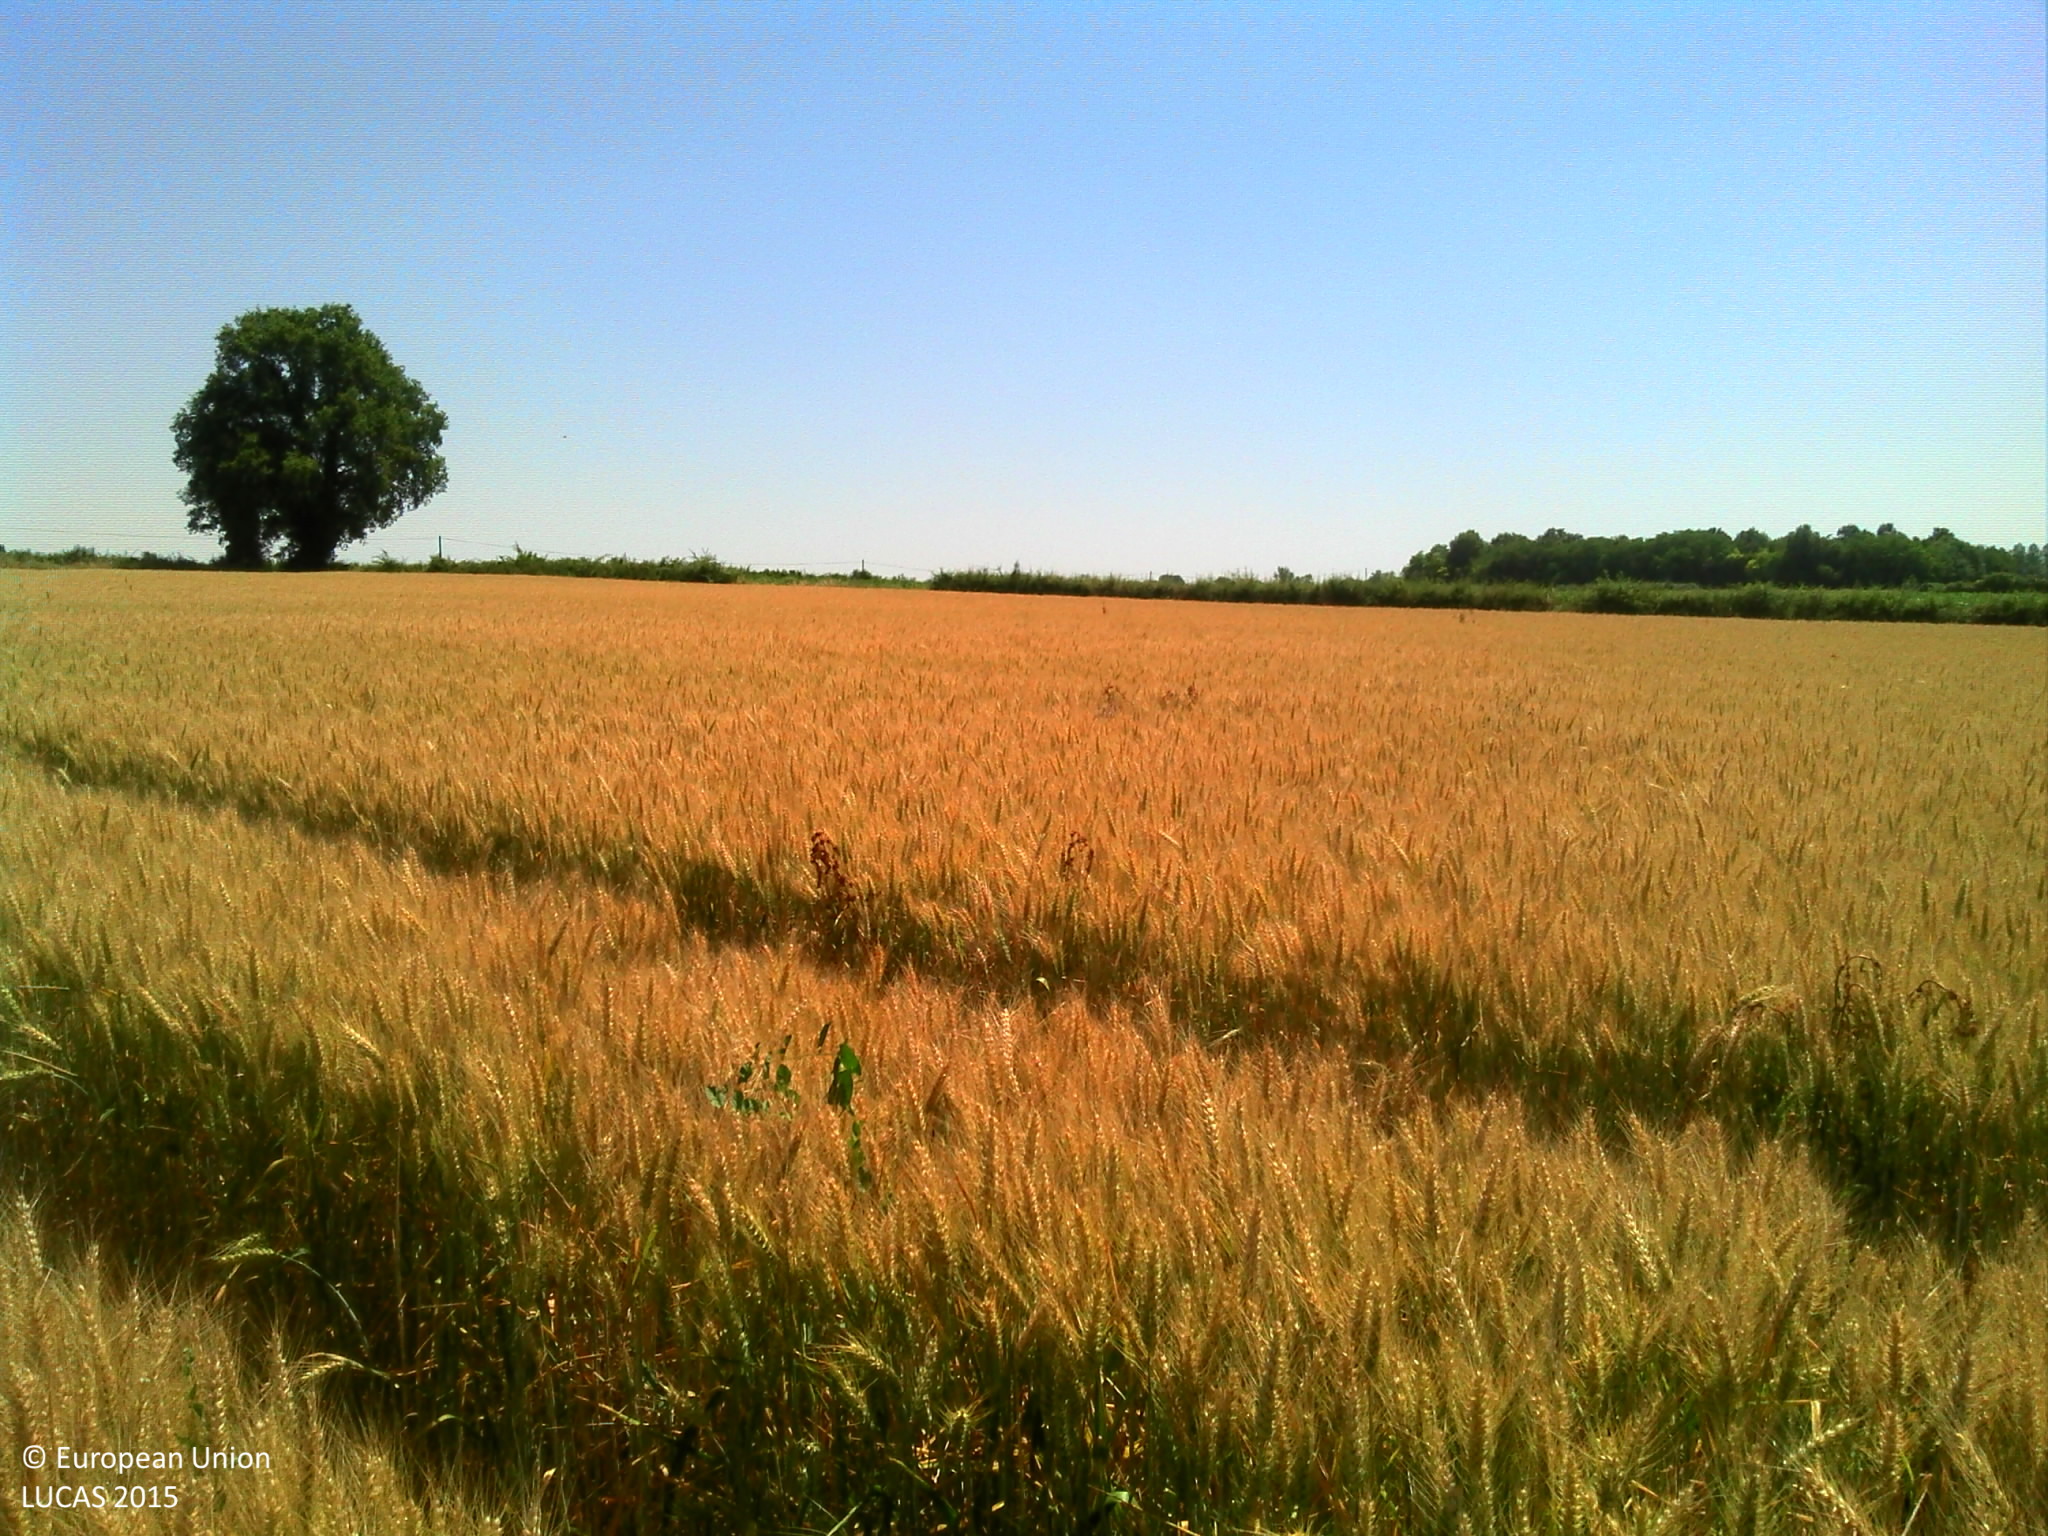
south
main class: Cropland
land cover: Durum wheat
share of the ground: > 75 %
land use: Agriculture (excluding fallow land and kitchen gardens)
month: June
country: FR
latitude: 47.5023
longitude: 0.2719
